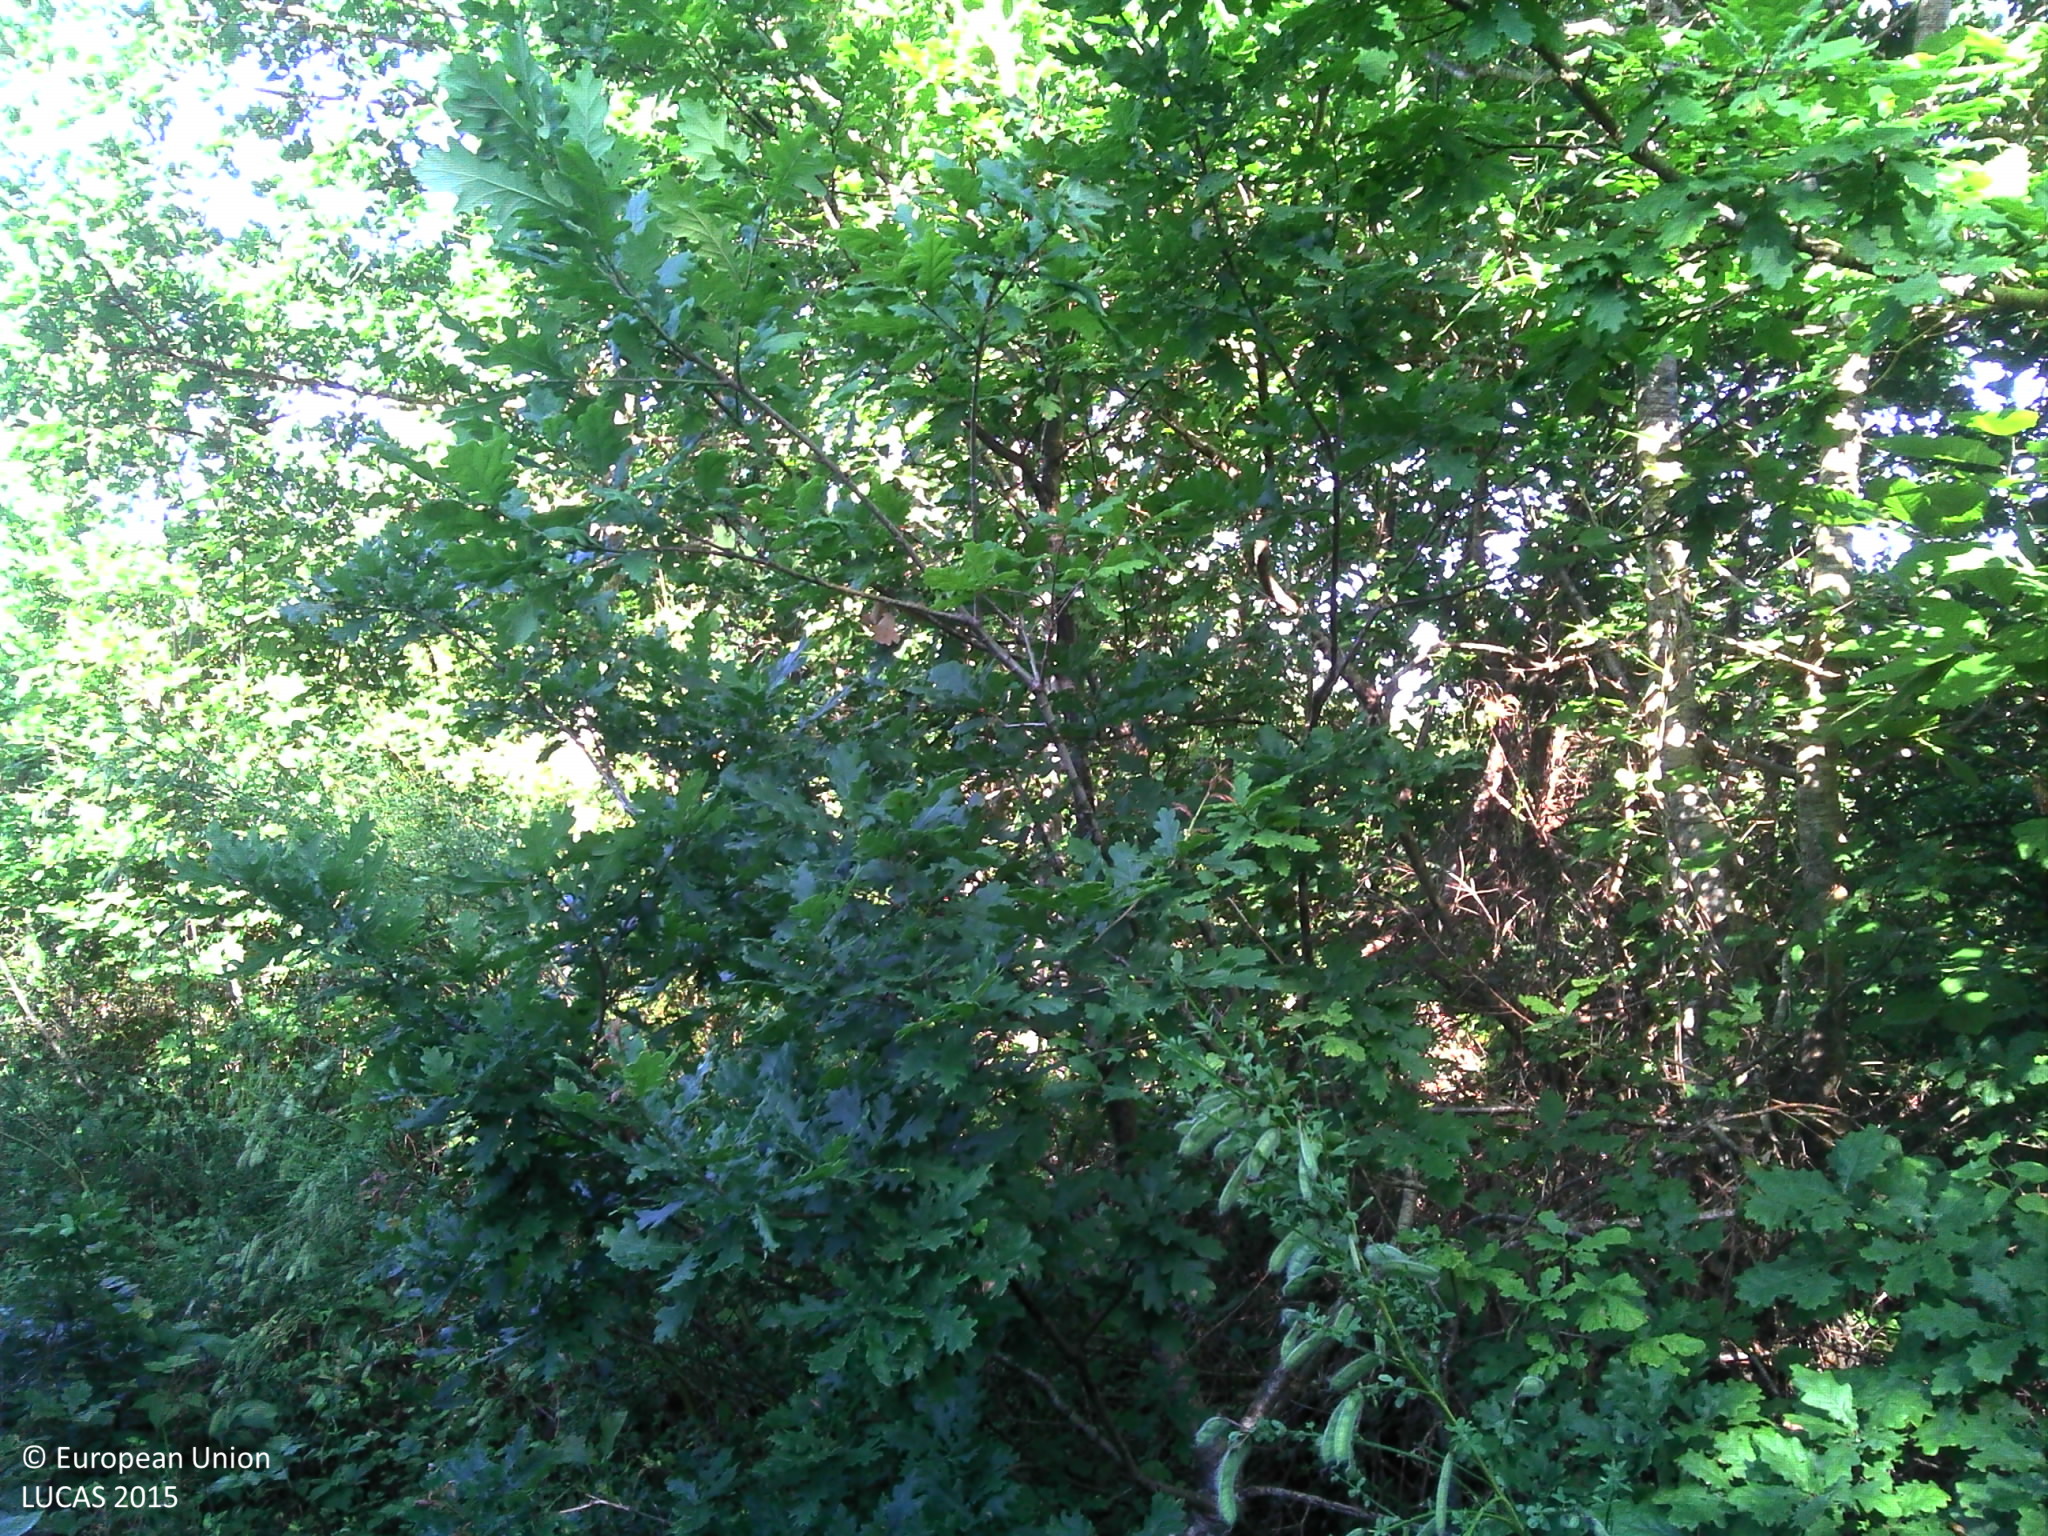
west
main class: Woodland
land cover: Broadleaved woodland
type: acidophilous oak and oak-birch forest
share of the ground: > 75 %
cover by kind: broadleaved forest trees 85 %, shrubs 10 %, herbaceous plants 5 %
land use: Semi-natural and natural areas not in use
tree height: > 5 m
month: June
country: FR
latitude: 45.8809
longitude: 0.3852
